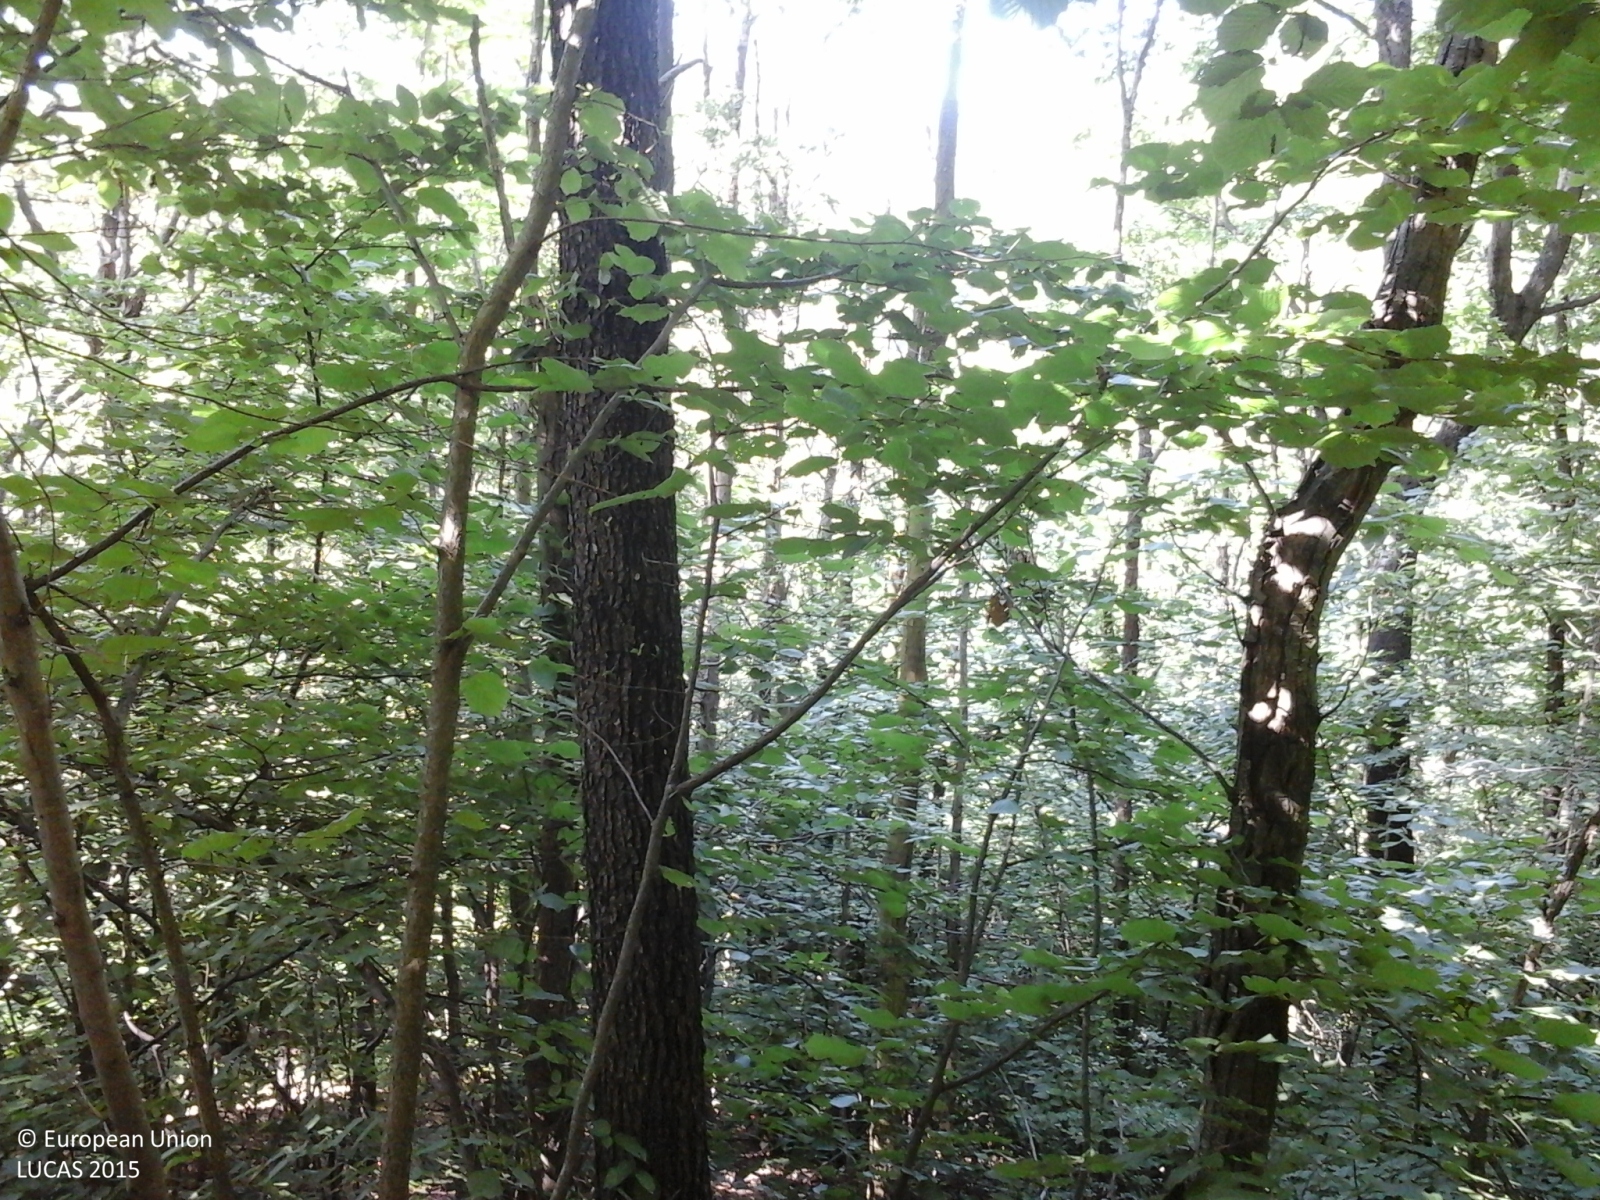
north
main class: Woodland
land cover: Broadleaved woodland
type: thermophilous deciduous forest
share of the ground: > 75 %
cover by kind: broadleaved forest trees 100 %
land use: Forestry
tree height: > 5 m
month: June
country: IT
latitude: 44.5884
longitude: 8.2528
